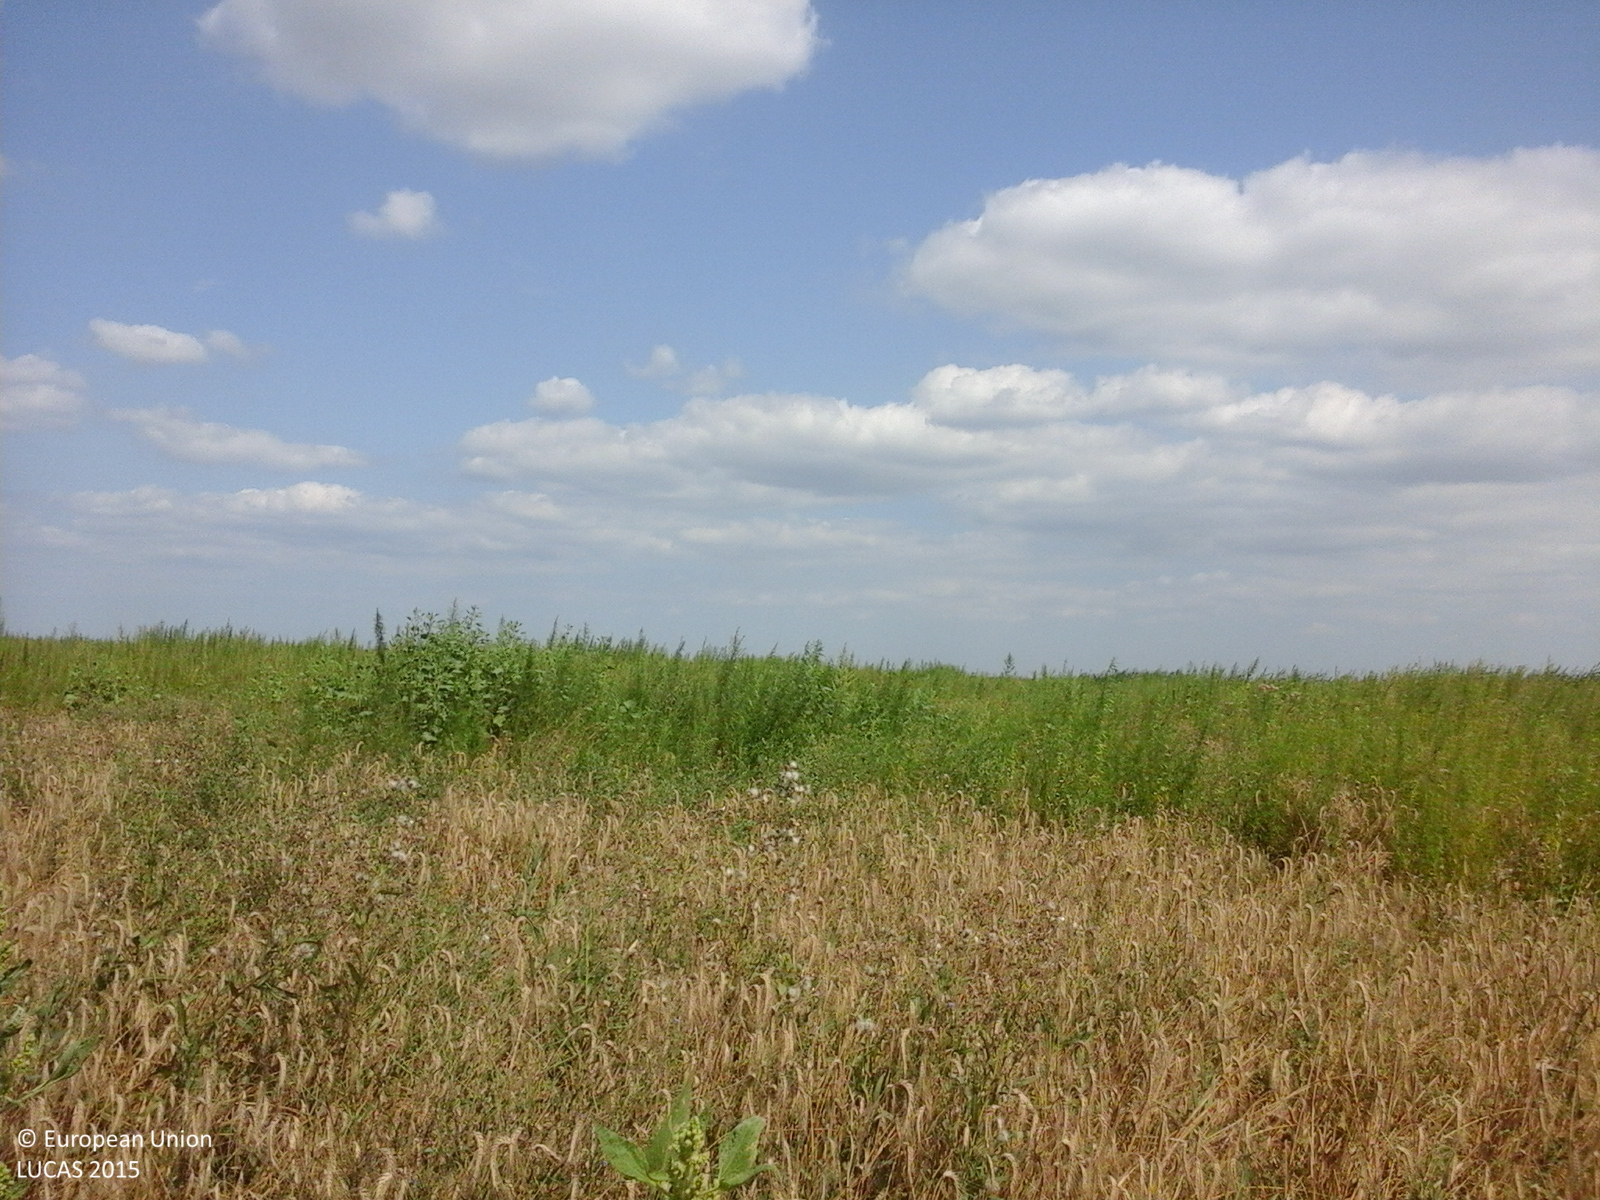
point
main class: Cropland
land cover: Barley
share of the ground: > 75 %
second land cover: Spontaneously vegetated surfaces
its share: > 75 %
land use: Agriculture (excluding fallow land and kitchen gardens)
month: August
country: RO
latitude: 45.2815
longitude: 29.1626
